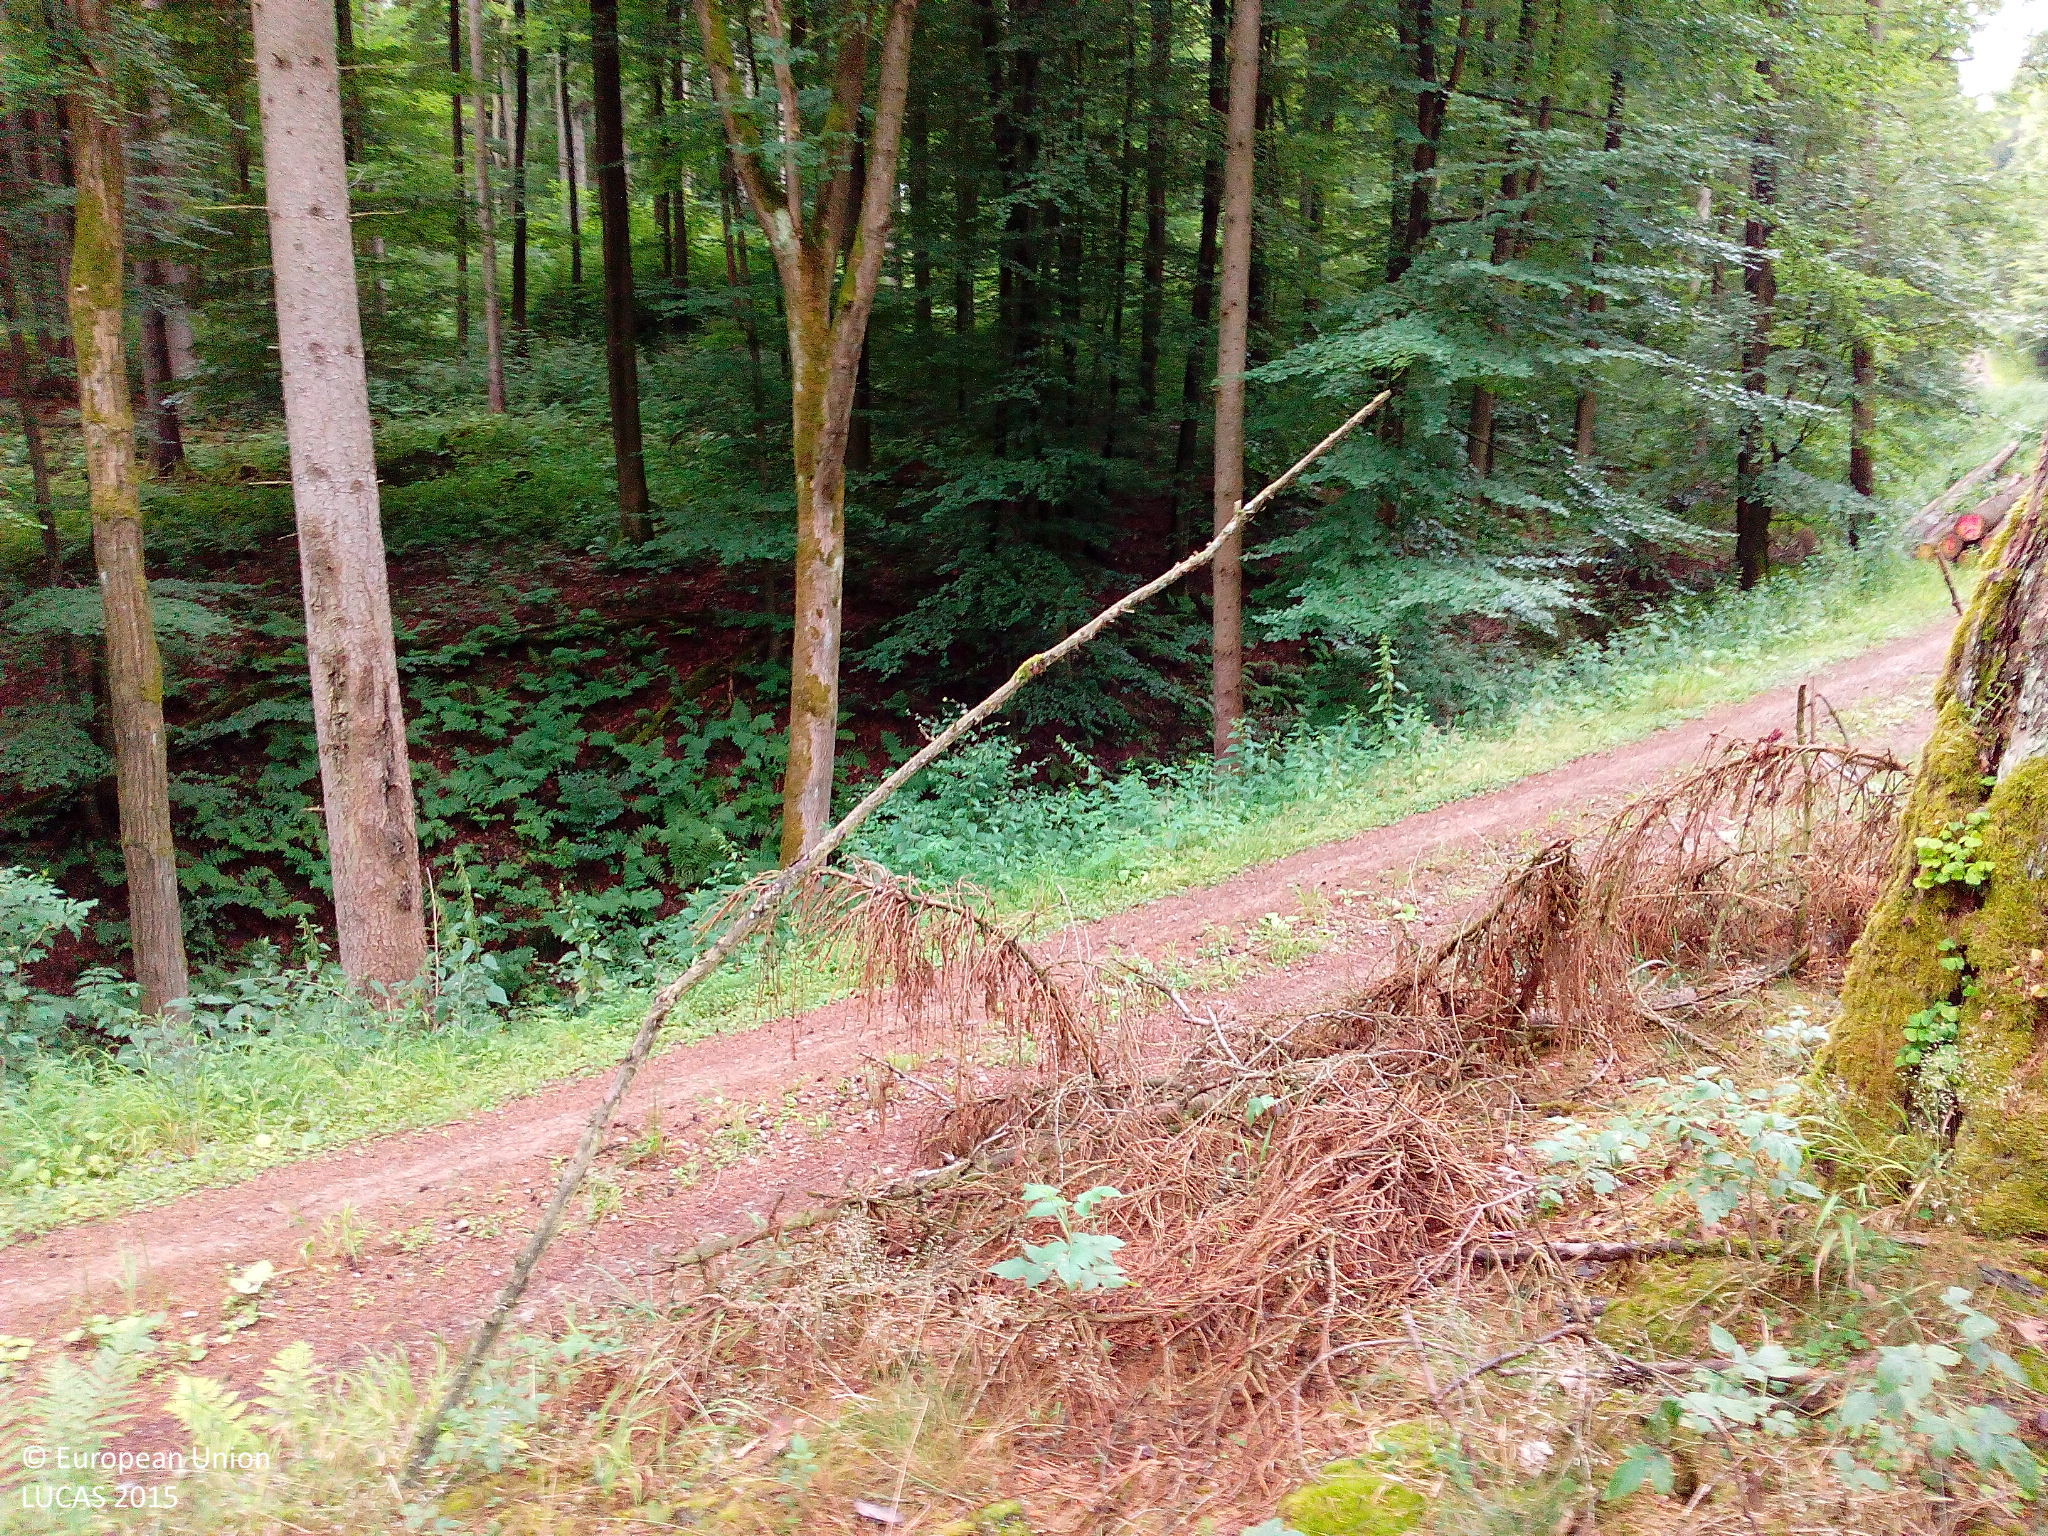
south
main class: Woodland
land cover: Spruce dominated mixed woodland
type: hemiboreal forest and nemoral coniferous forest and mixed broadleaved-coniferous forest
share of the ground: > 75 %
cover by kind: coniferous forest trees 40 %, broadleaved forest trees 30 %, unconsolidated bare surface 20 %, herbaceous plants 5 %, lichens and mosses 5 %
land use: Forestry
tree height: > 5 m
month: July
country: DE
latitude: 51.0292
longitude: 9.8717
